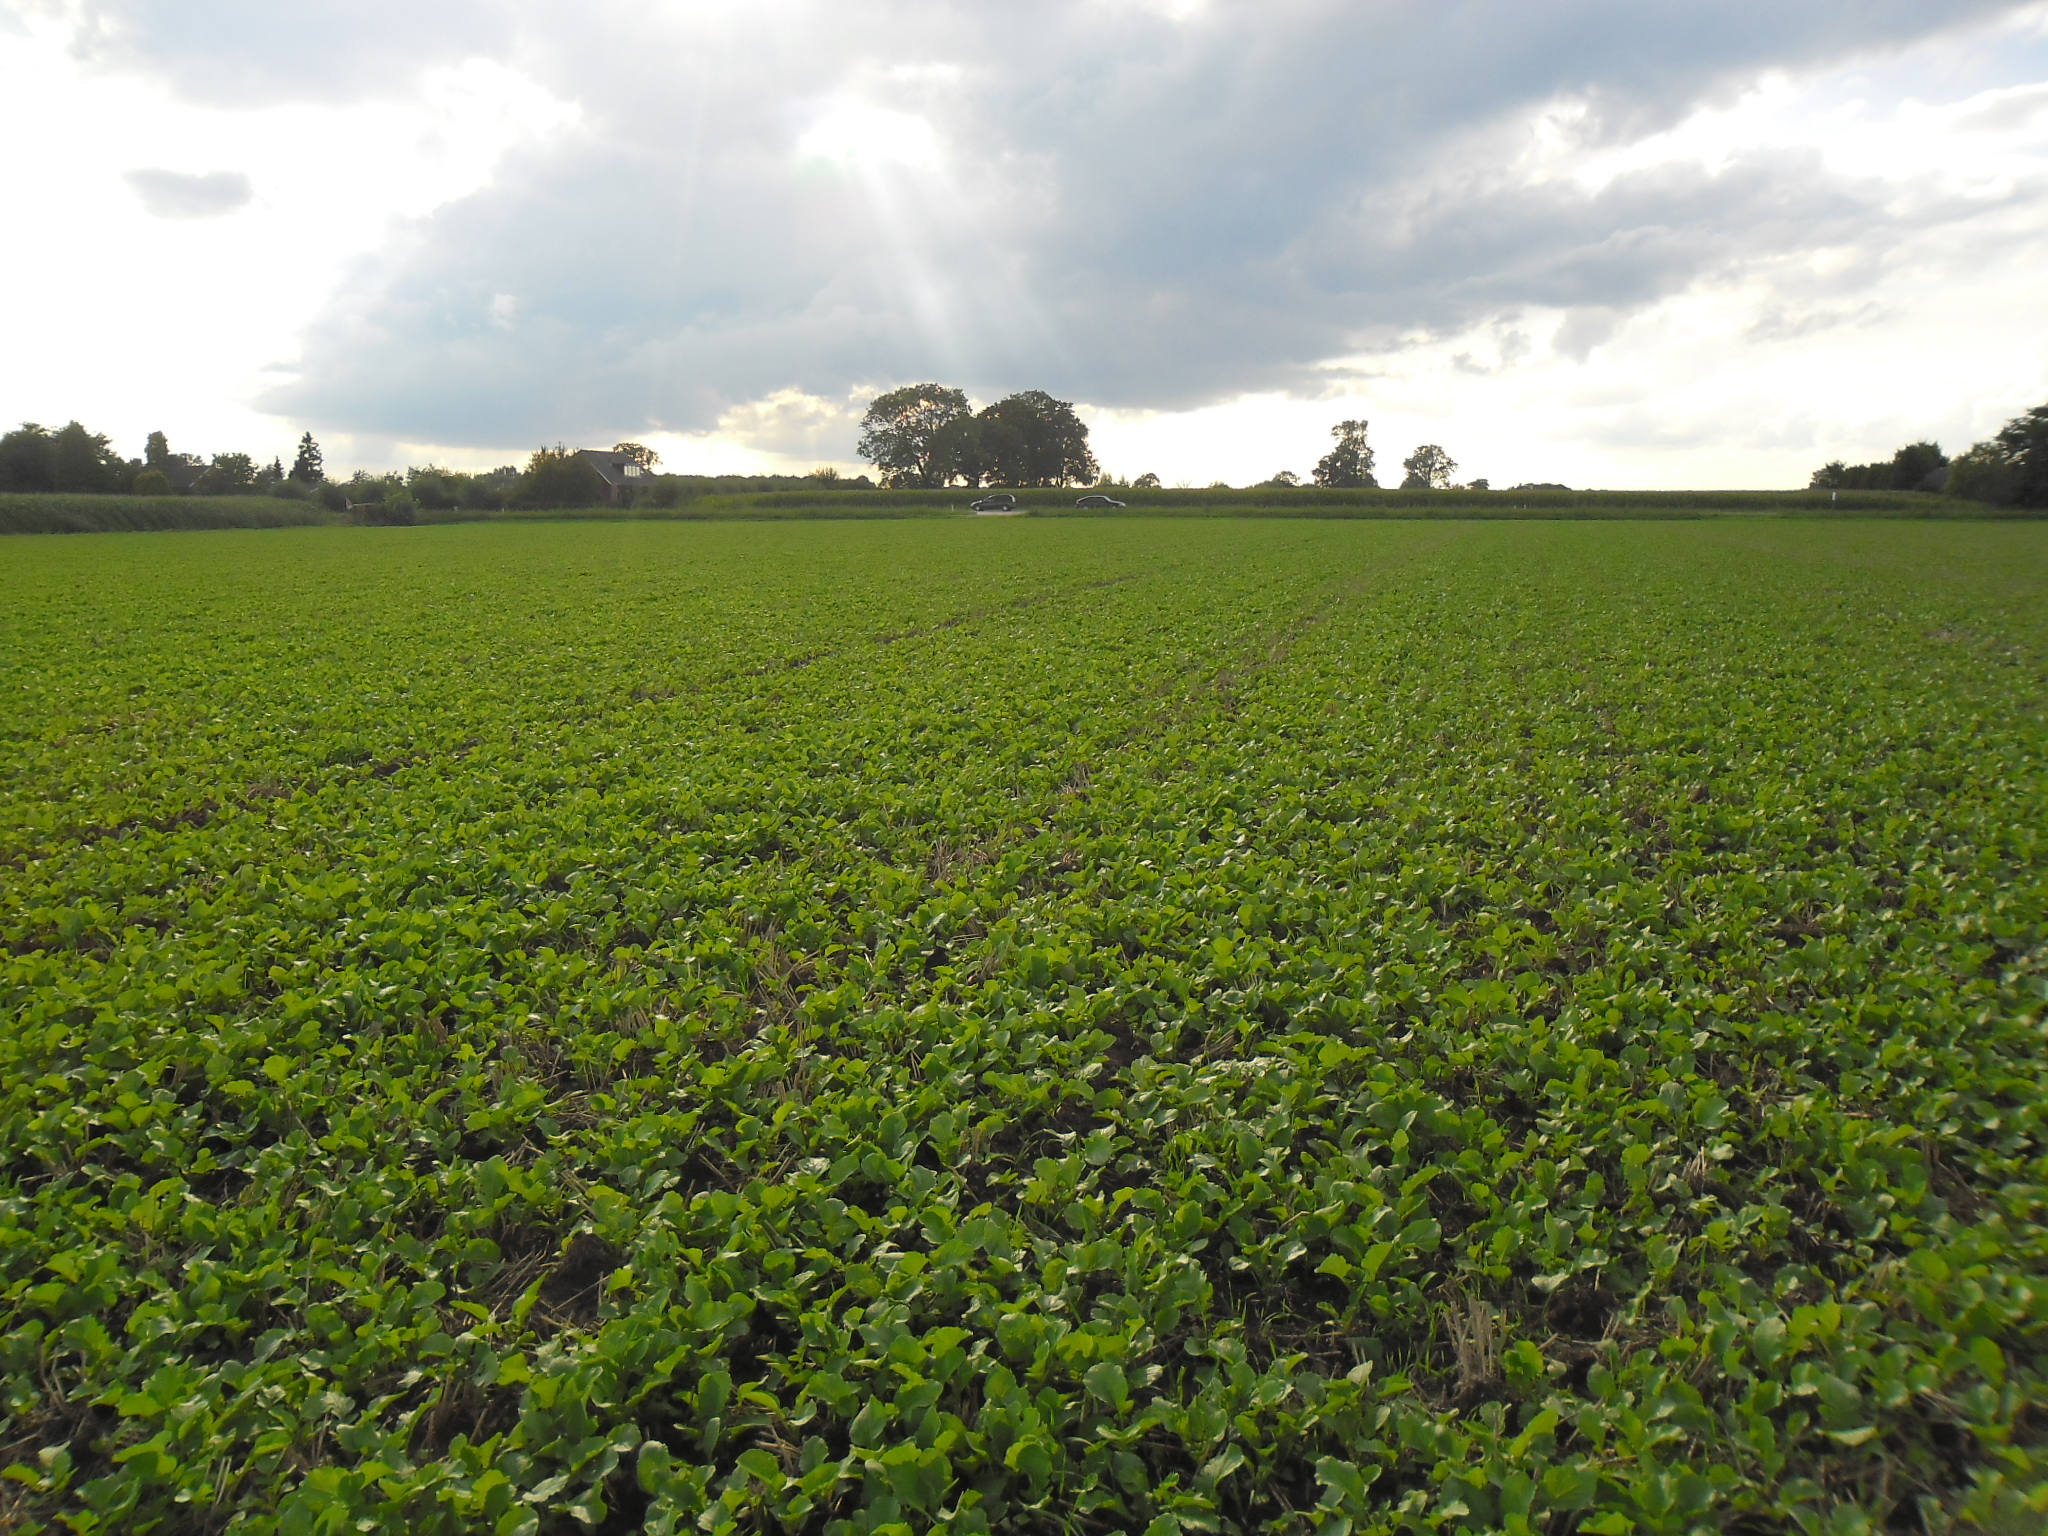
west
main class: Cropland
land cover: Common wheat
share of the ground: < 10 %
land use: Agriculture (excluding fallow land and kitchen gardens)
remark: Harvested field
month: September
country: NL
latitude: 52.0475
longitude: 6.2228
